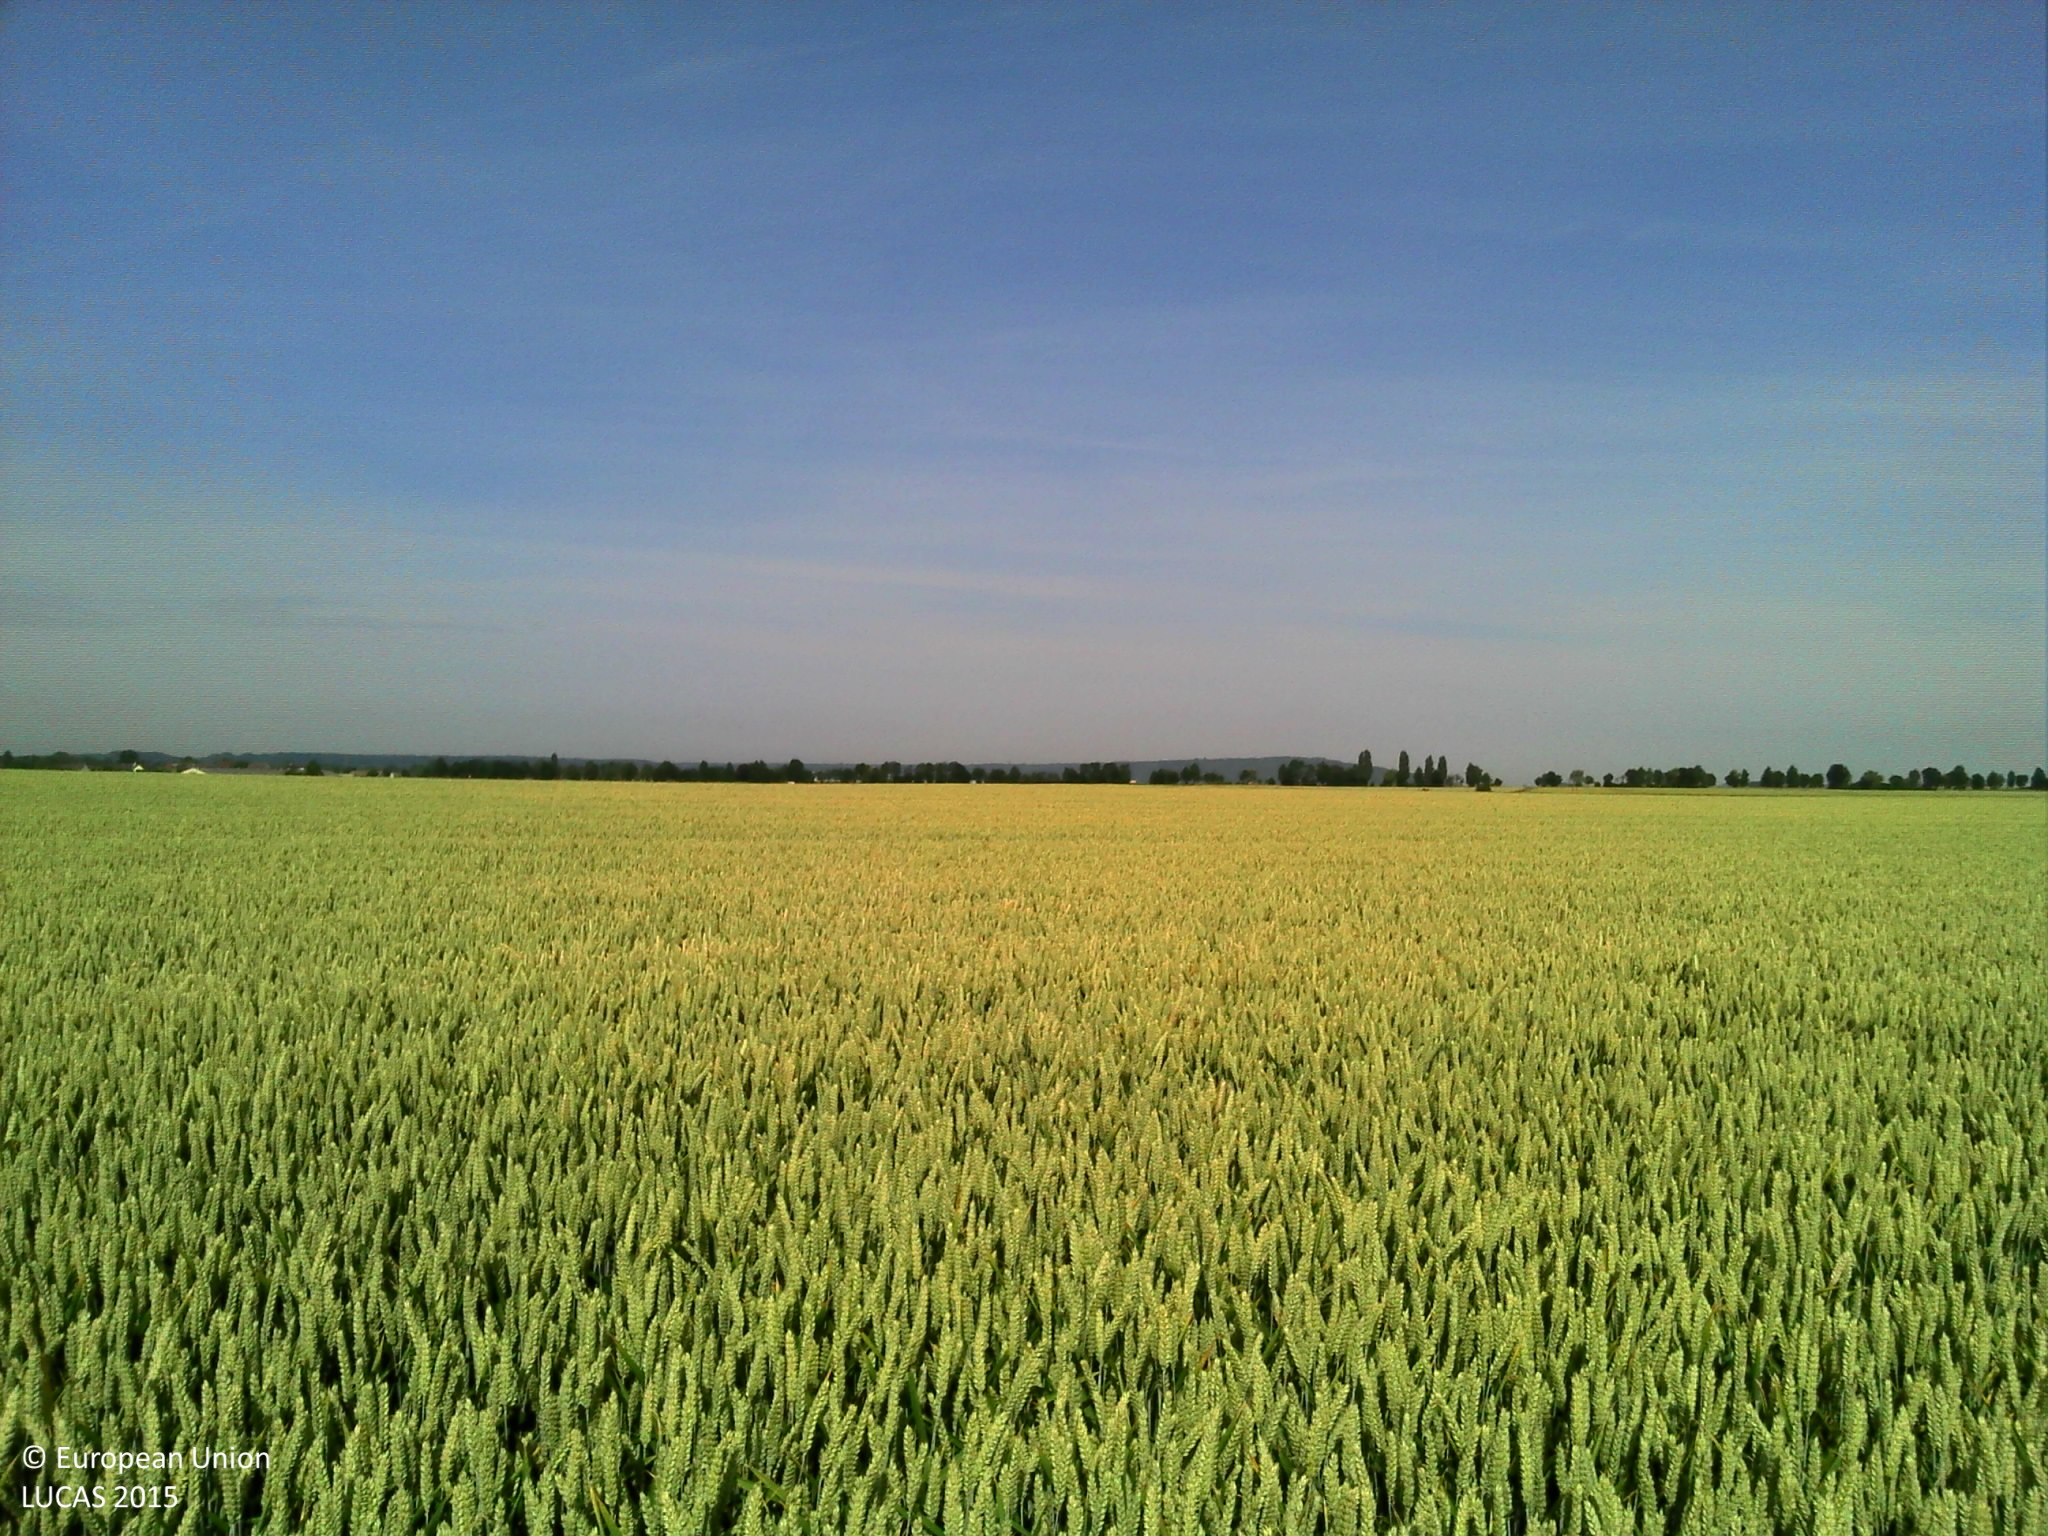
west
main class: Cropland
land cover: Common wheat
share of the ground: > 75 %
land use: Agriculture (excluding fallow land and kitchen gardens)
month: June
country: FR
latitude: 49.3492
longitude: 2.6242
